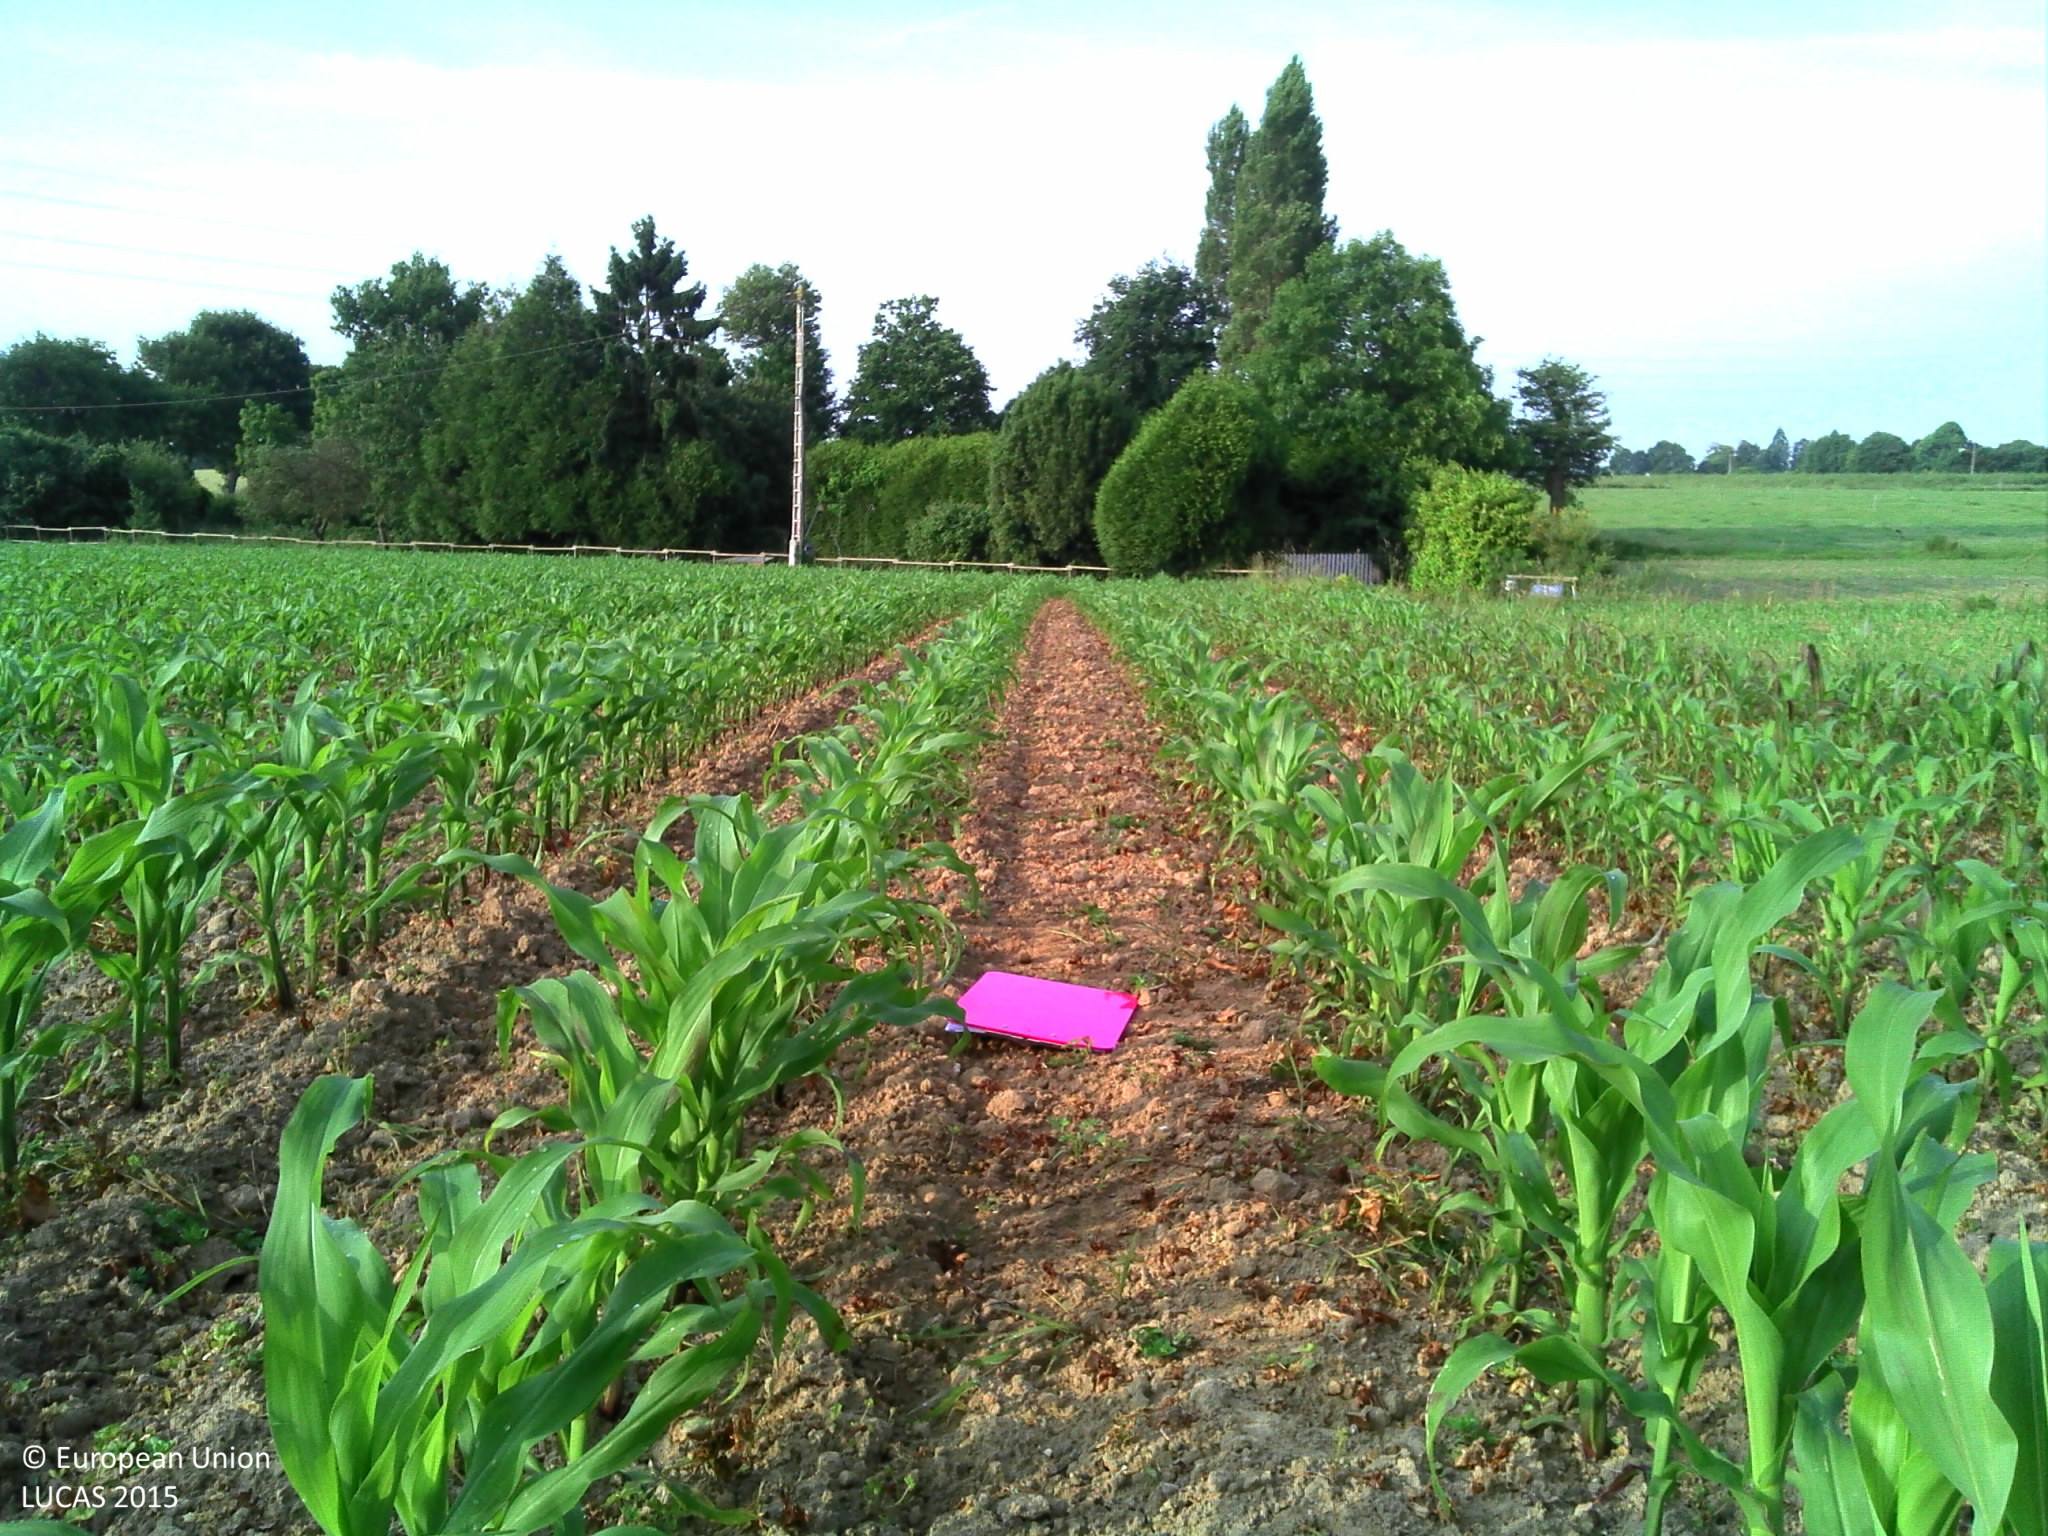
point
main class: Cropland
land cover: Maize
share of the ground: 25 - 50 %
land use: Agriculture (excluding fallow land and kitchen gardens)
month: June
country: FR
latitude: 48.1559
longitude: -1.9218
